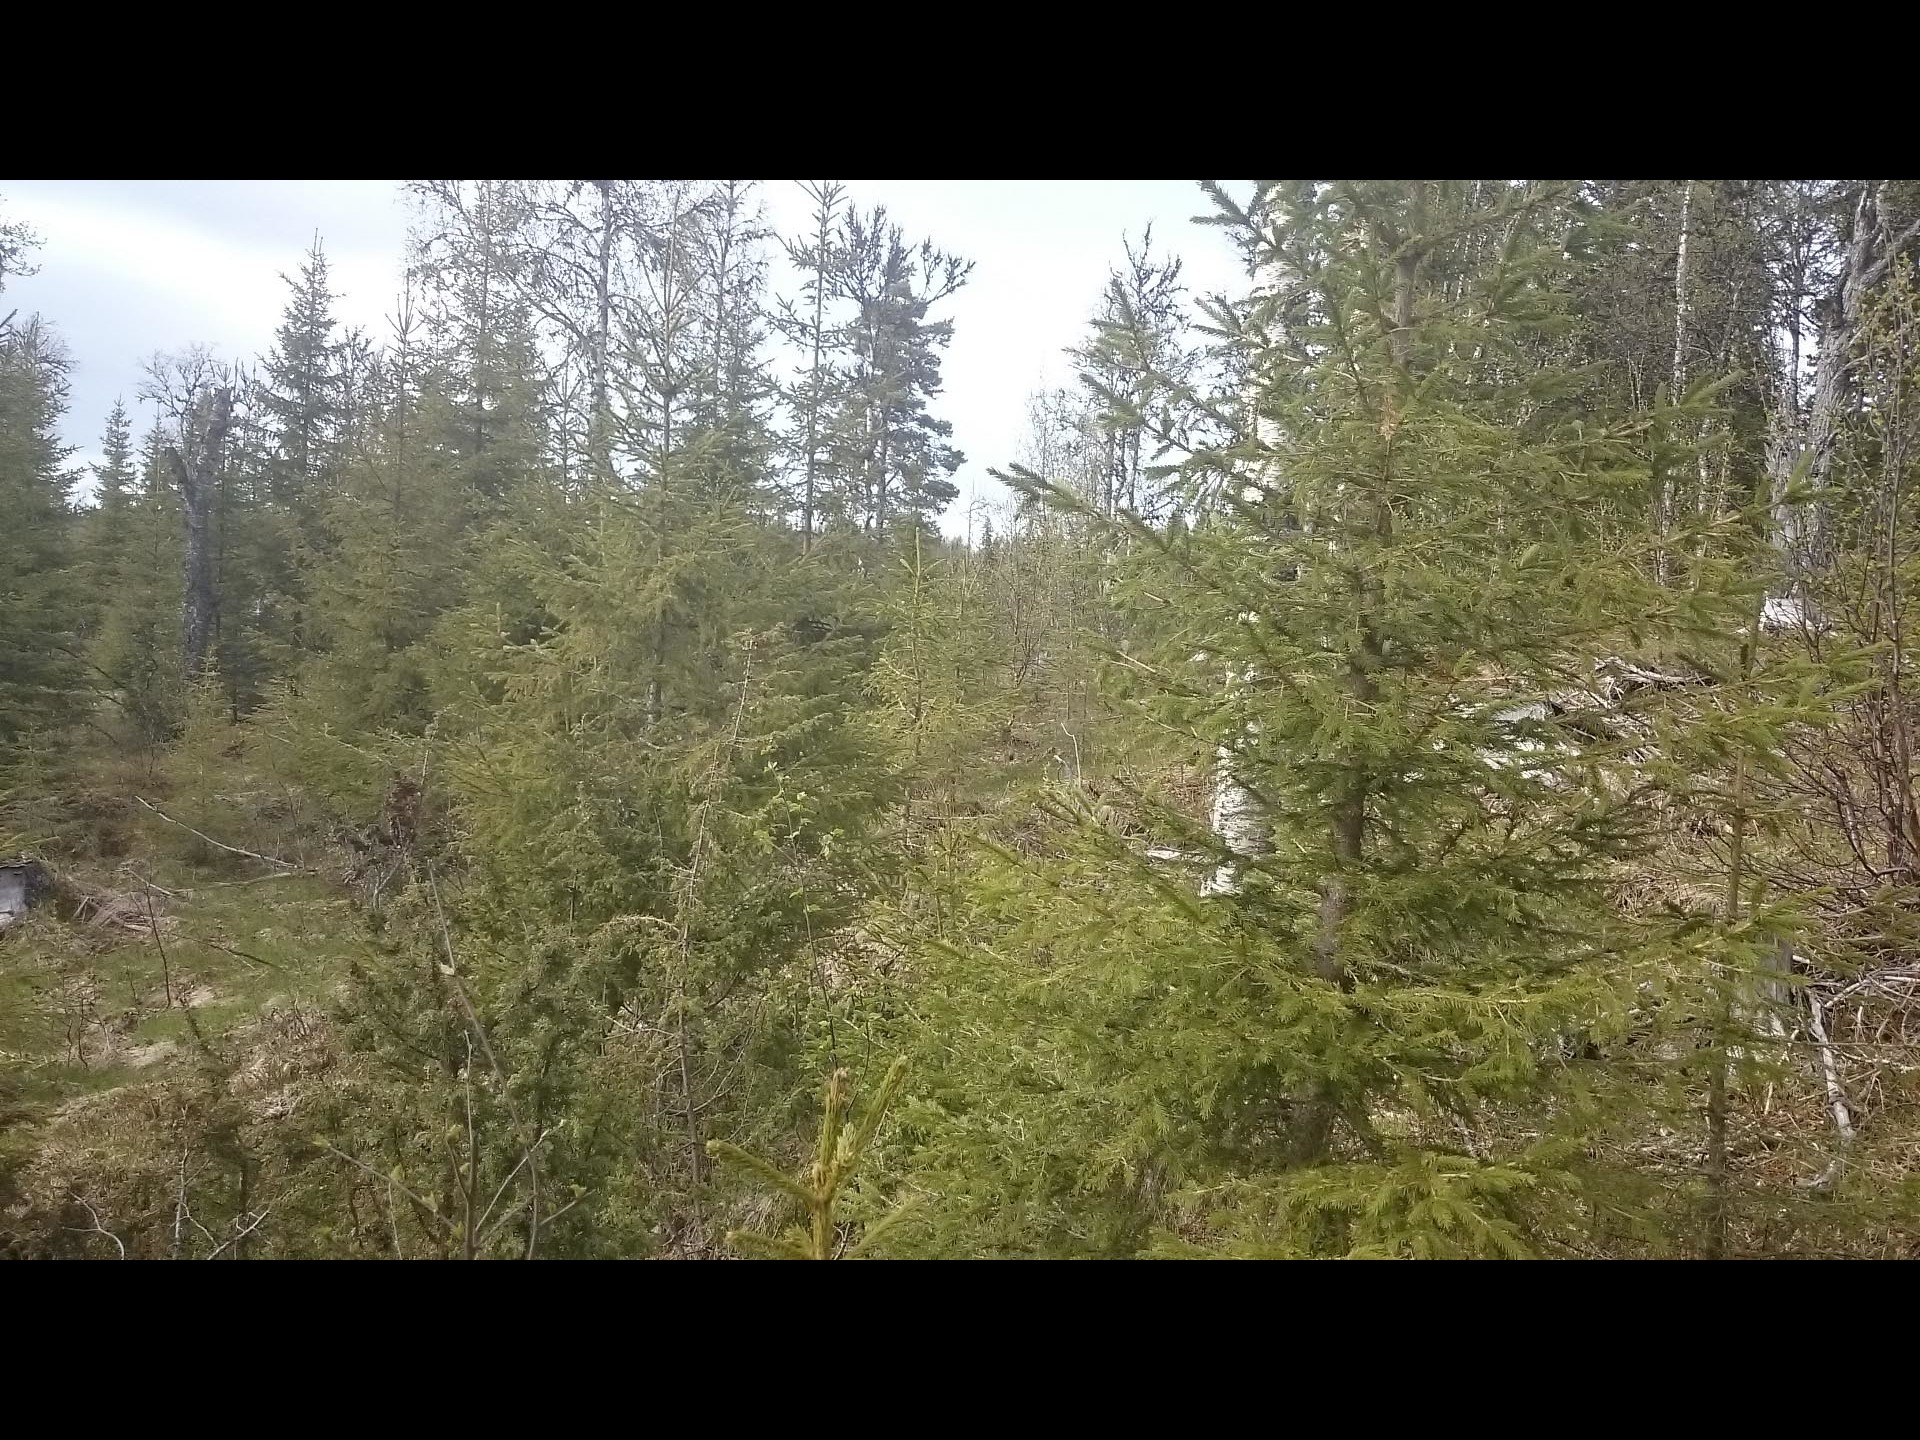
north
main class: Woodland
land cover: Spruce dominated mixed woodland
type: boreal forest
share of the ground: 25 - 50 %
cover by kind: herbaceous plants 35 %, coniferous forest trees 30 %, shrubs 25 %, broadleaved forest trees 10 %
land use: Forestry
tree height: < 5 m
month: June
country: SE
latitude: 63.7189
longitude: 13.8459
